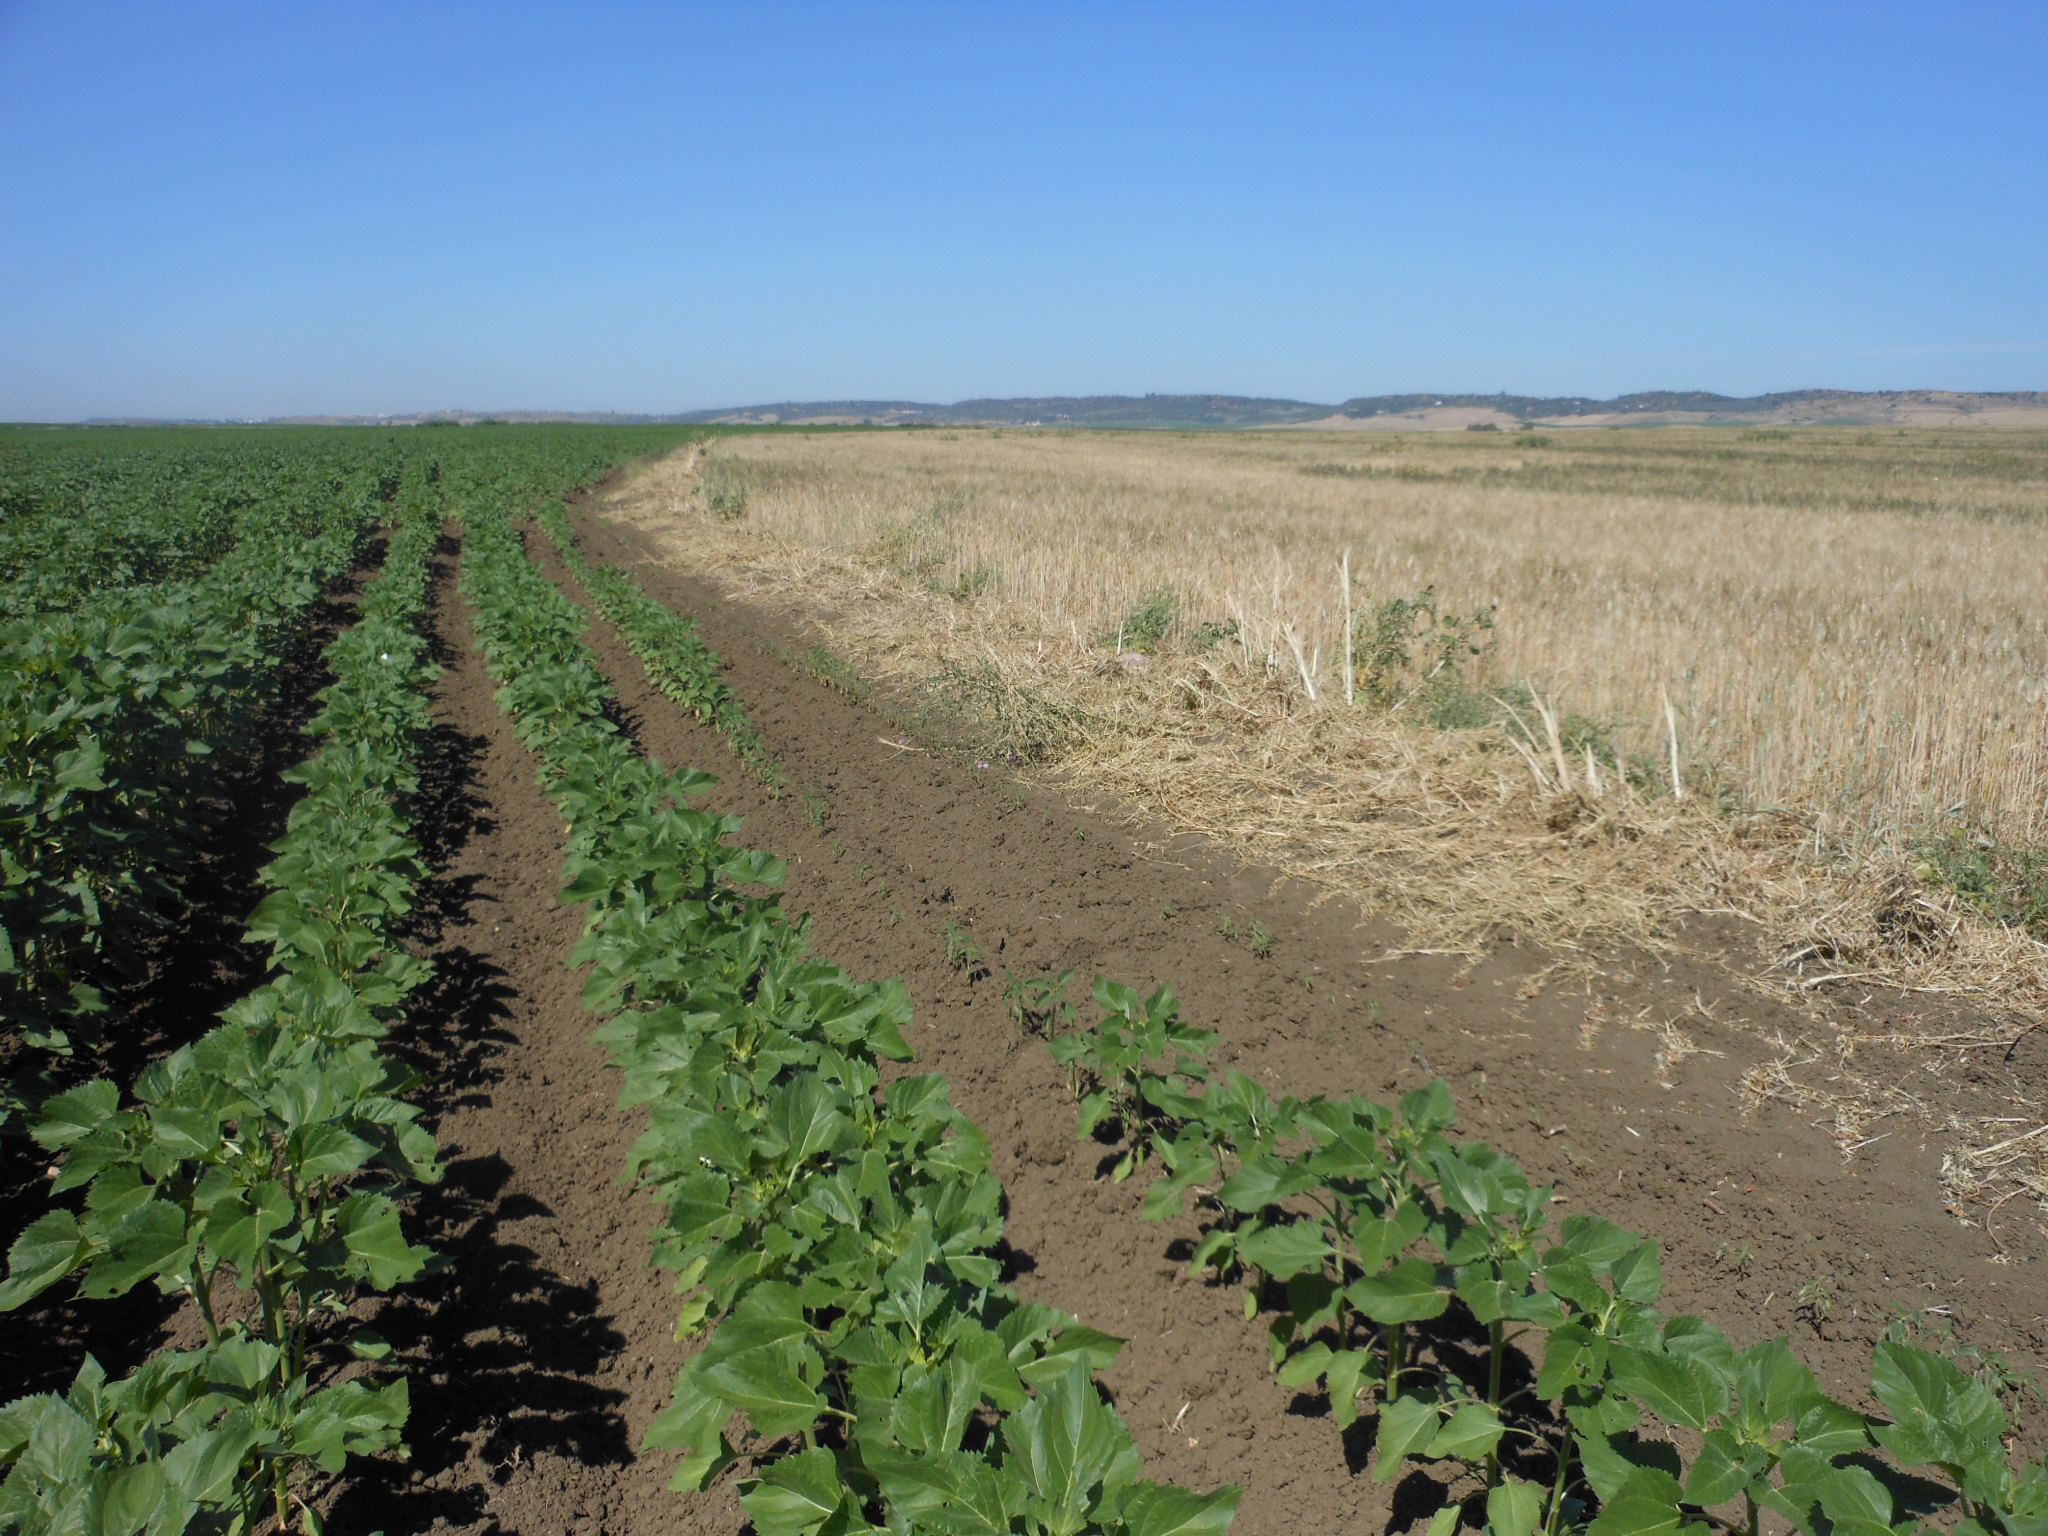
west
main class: Cropland
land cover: Sunflower
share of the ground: 25 - 50 %
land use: Agriculture (excluding fallow land and kitchen gardens)
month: May
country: ES
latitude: 37.4277
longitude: -5.6018
